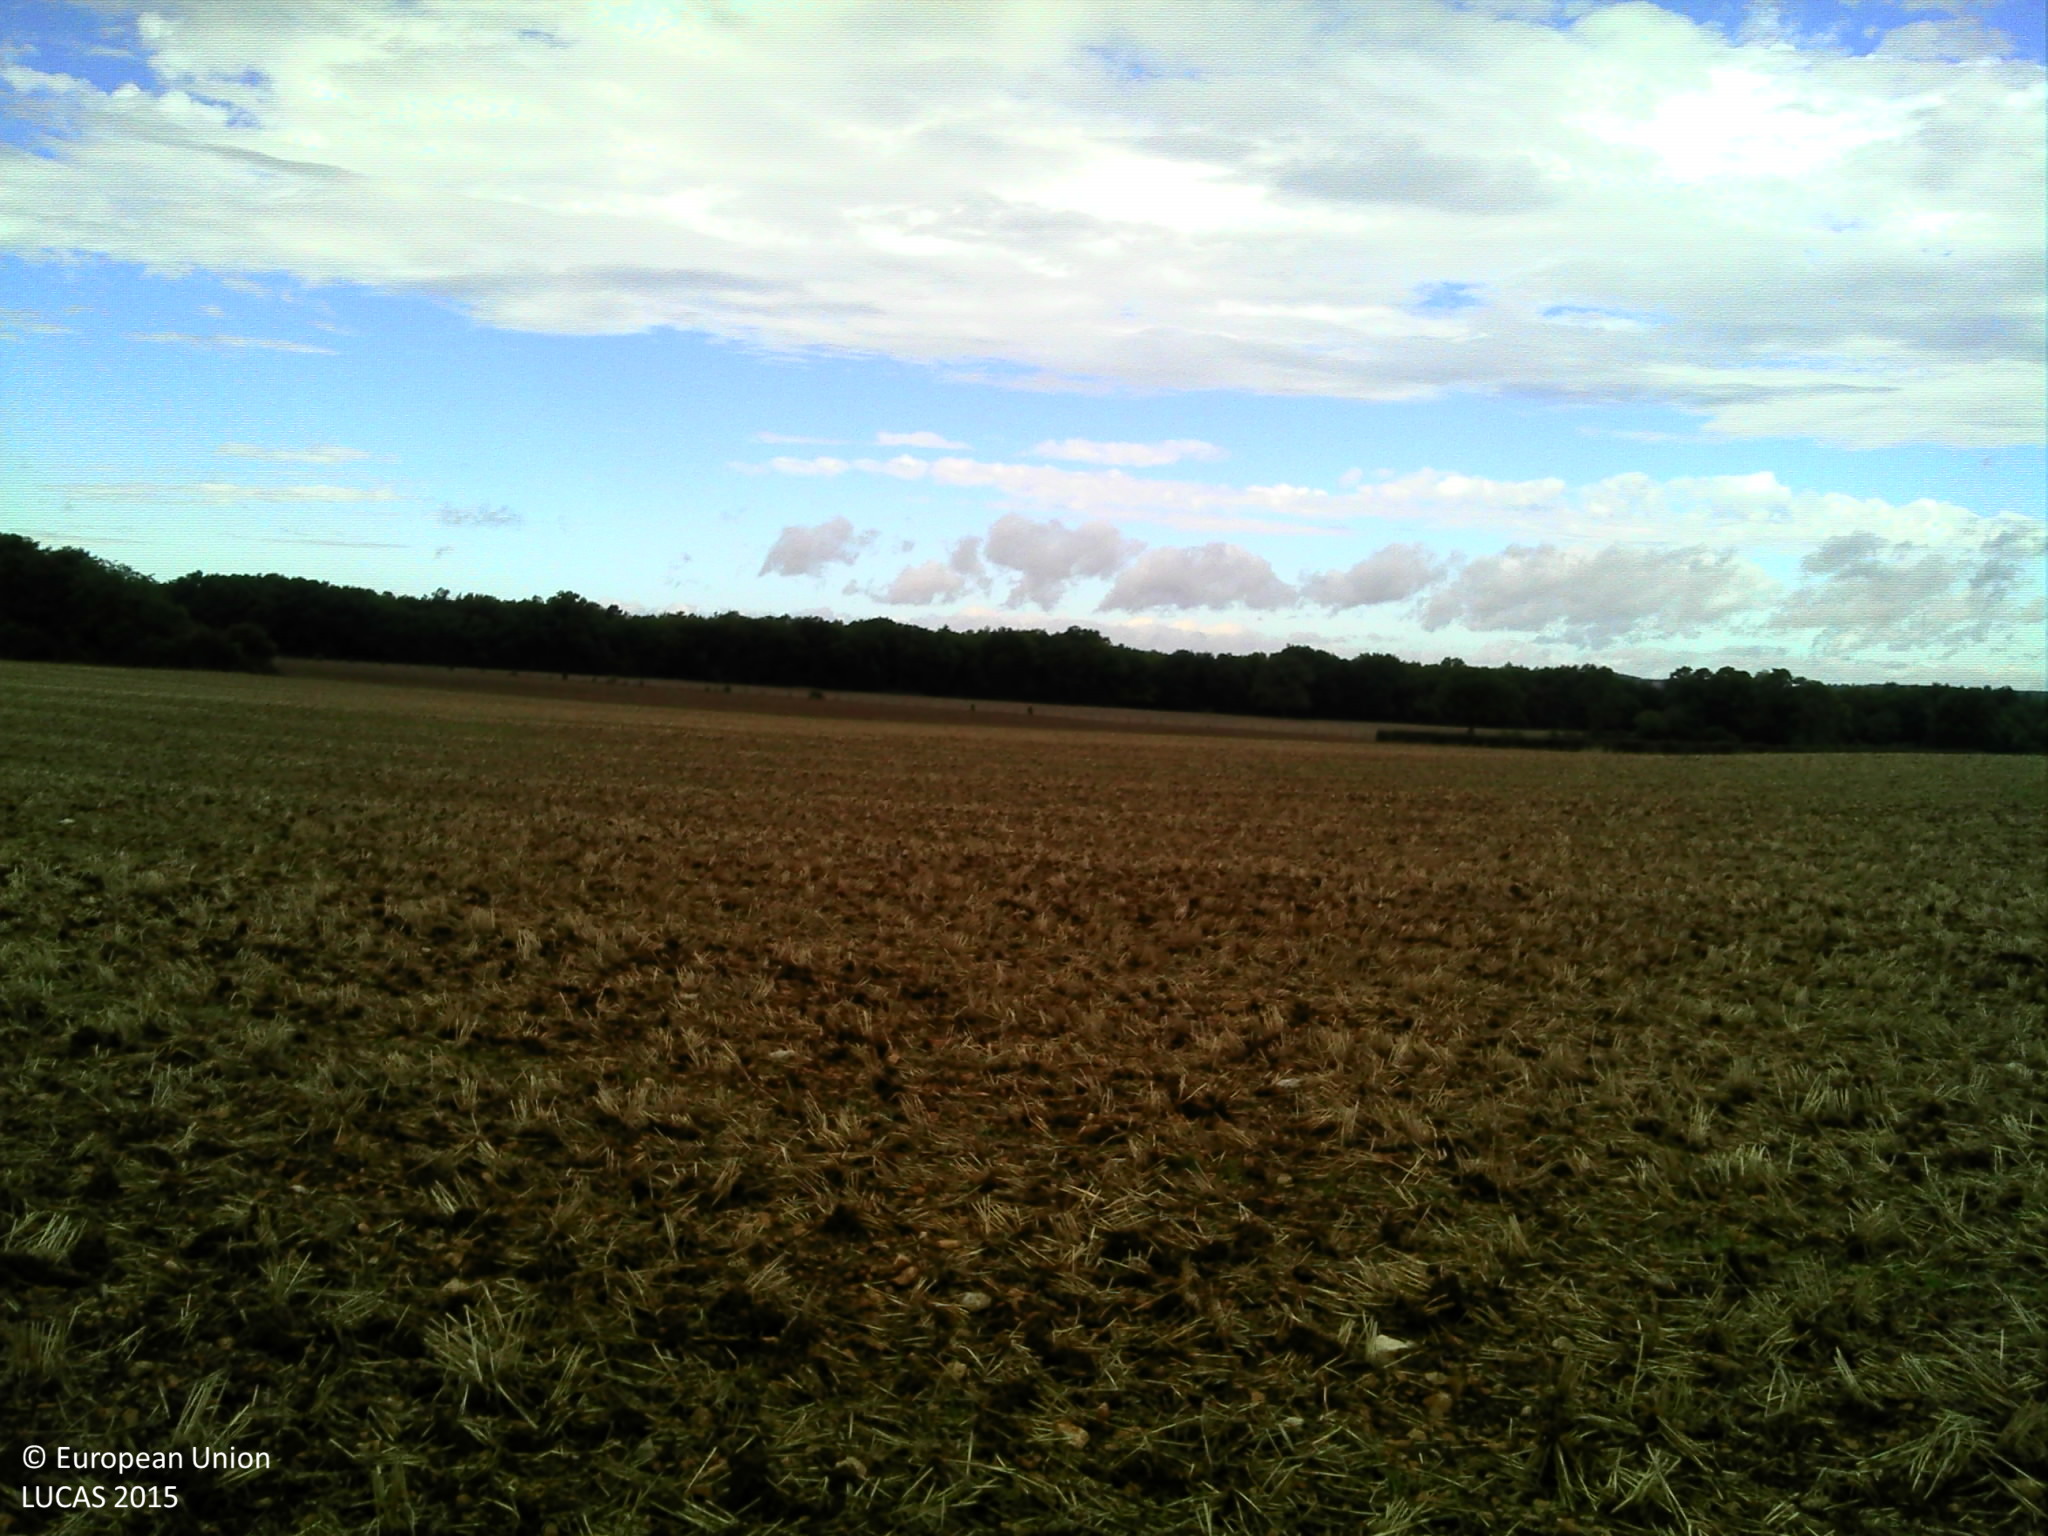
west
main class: Cropland
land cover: Common wheat
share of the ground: 10 - 25 %
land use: Agriculture (excluding fallow land and kitchen gardens)
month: August
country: FR
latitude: 47.8972
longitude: 4.6884
